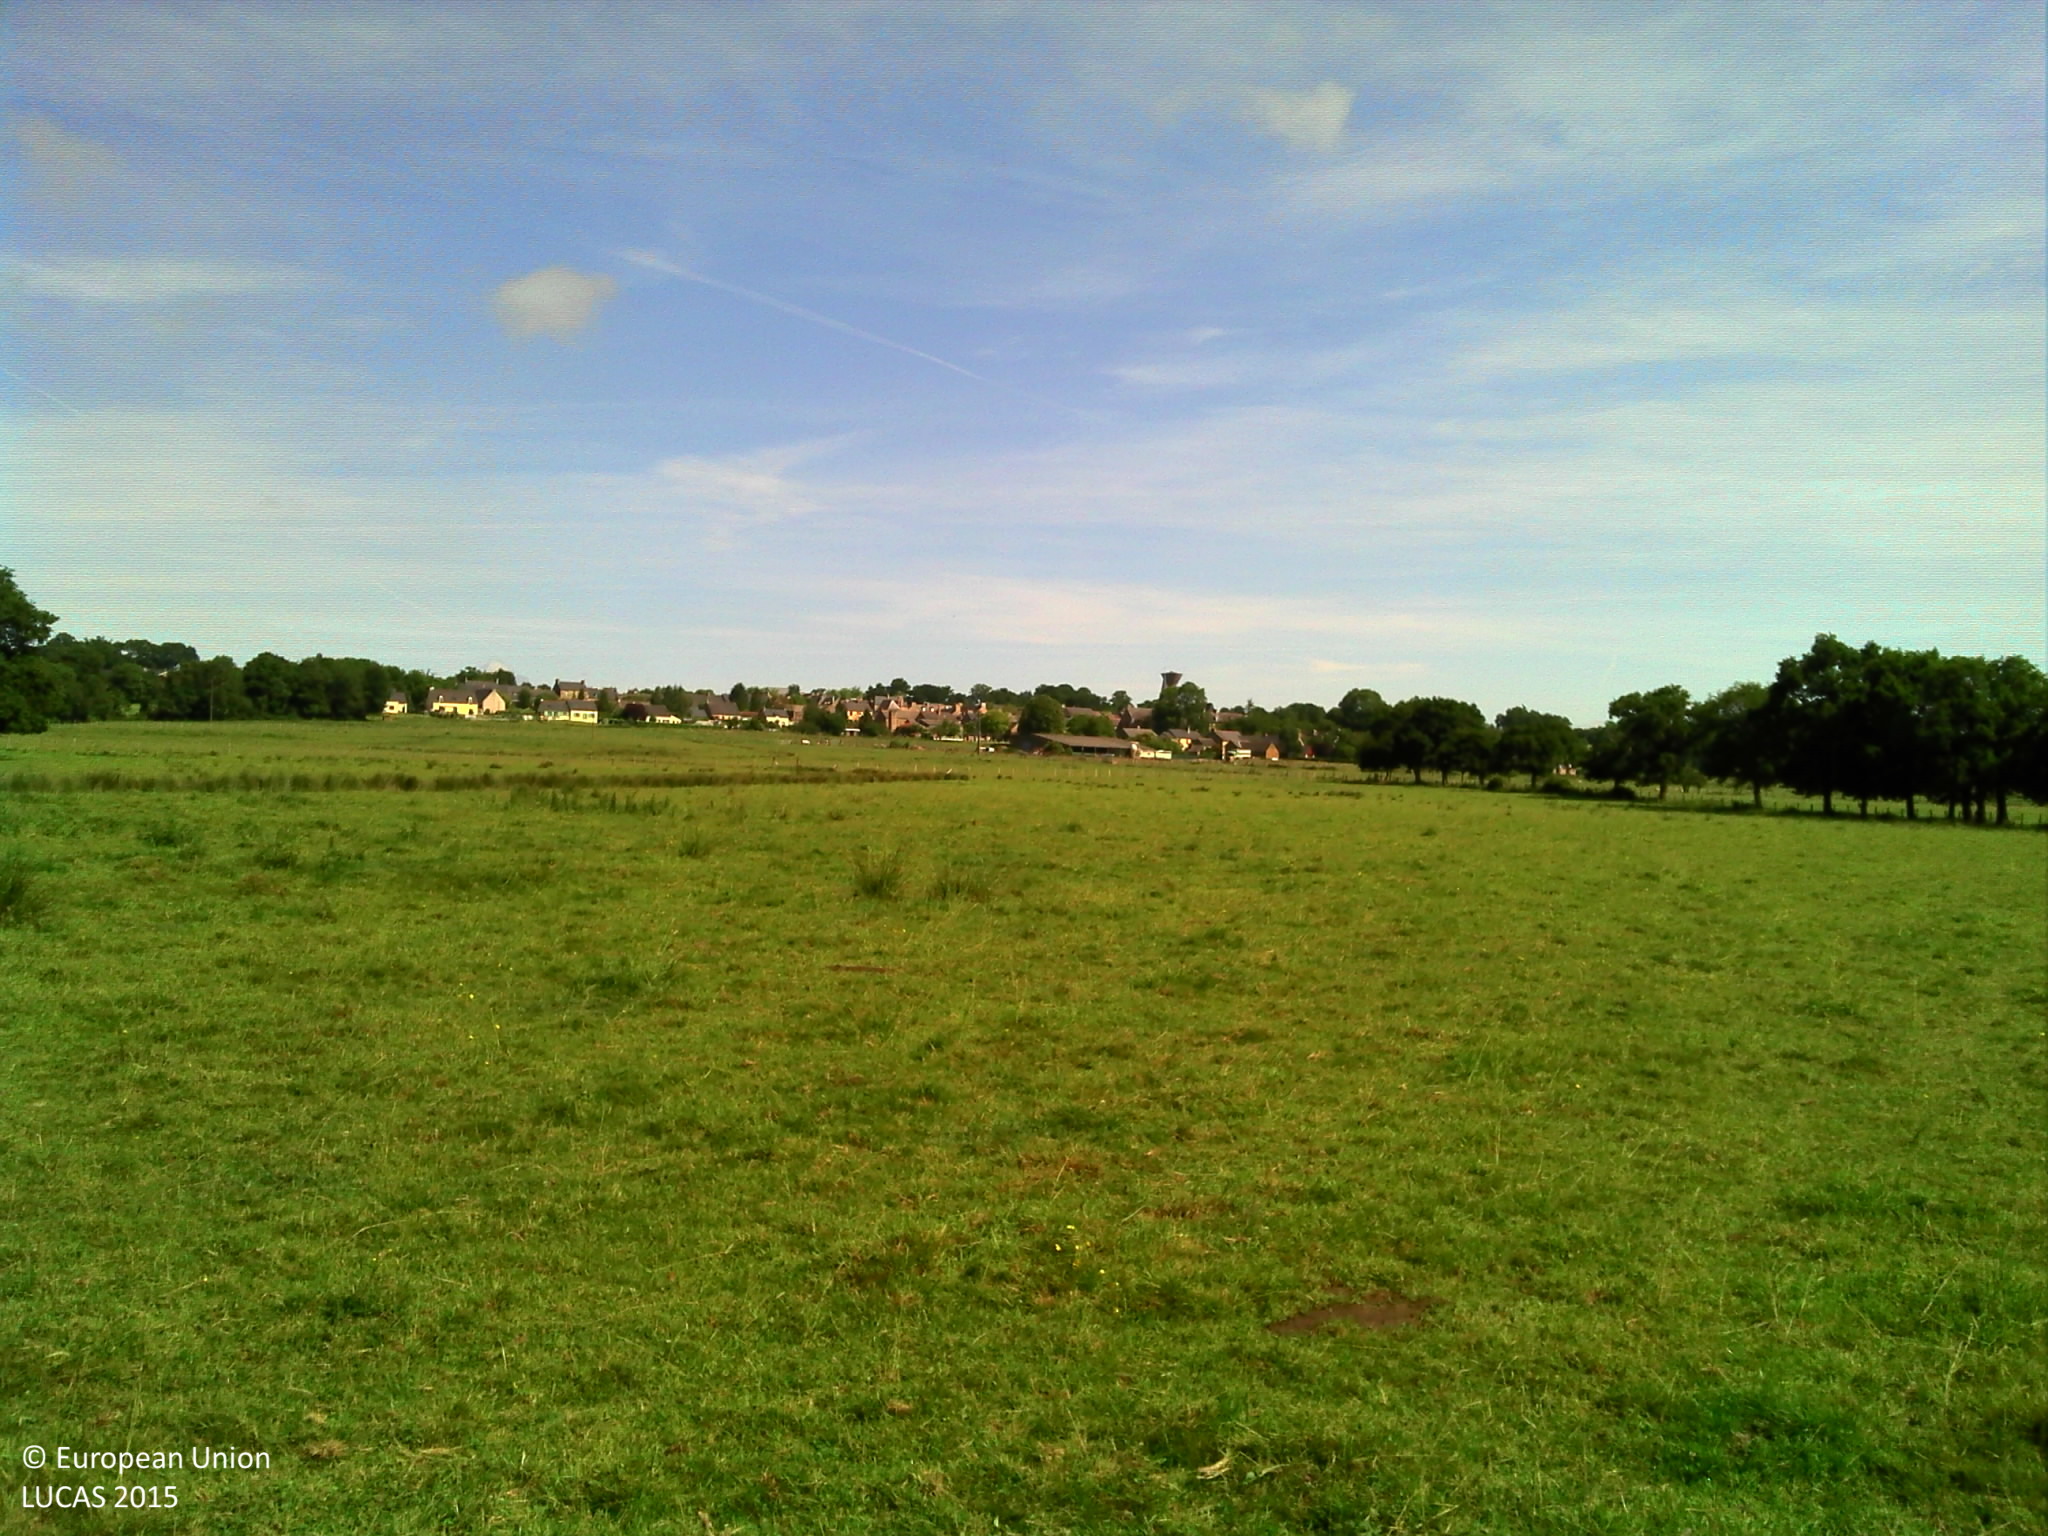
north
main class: Grassland
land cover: Grassland without tree/shrub cover
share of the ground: > 75 %
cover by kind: herbaceous plants 100 %
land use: Agriculture (excluding fallow land and kitchen gardens)
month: June
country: FR
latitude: 48.2902
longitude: -1.5165
